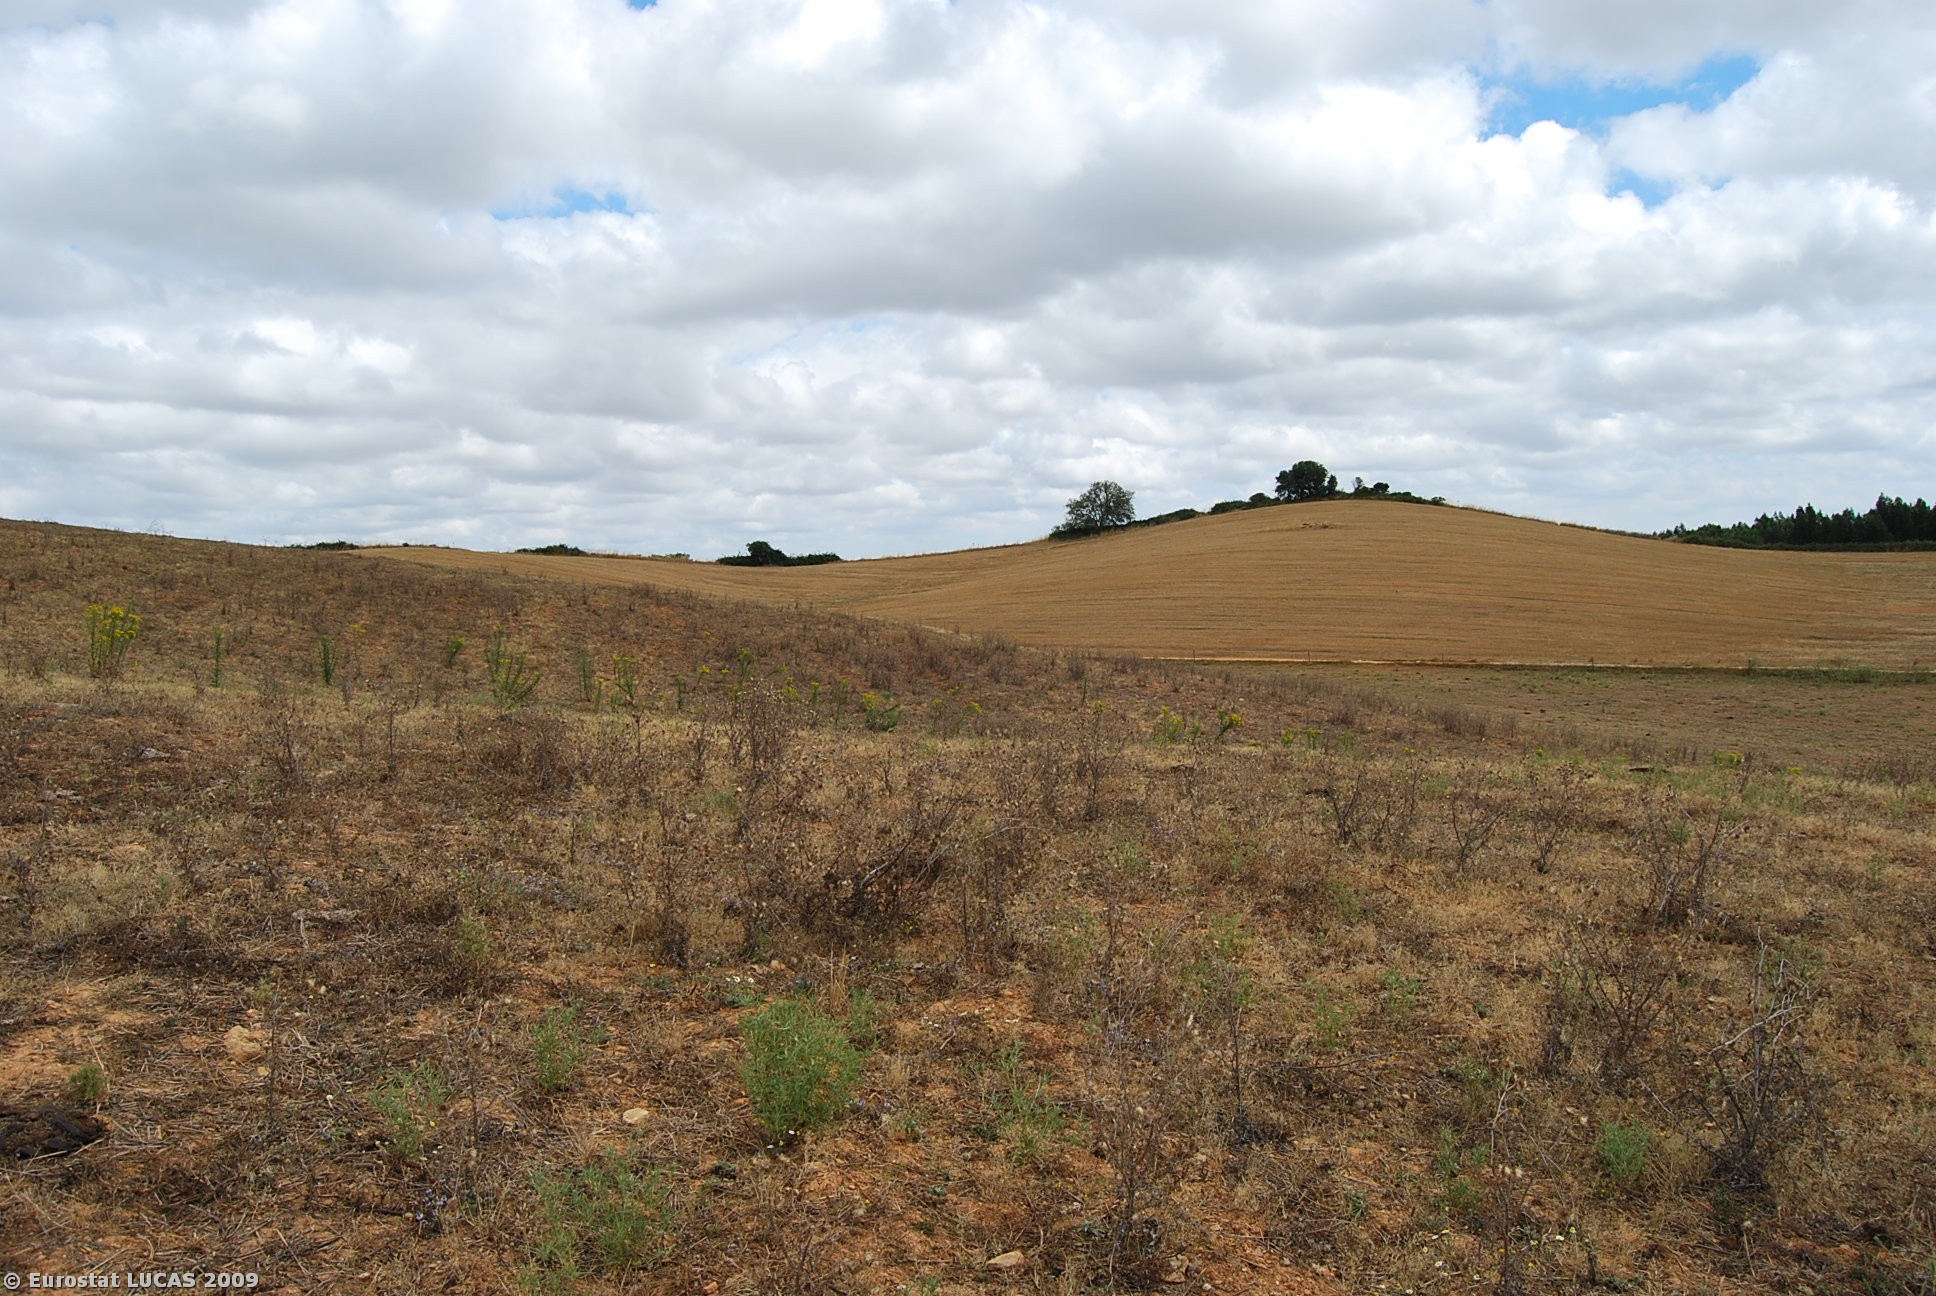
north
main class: Grassland
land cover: Grassland without tree/shrub cover
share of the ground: > 75 %
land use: Agriculture (excluding fallow land and kitchen gardens)
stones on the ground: 10 - 25 %
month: June
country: PT
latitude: 37.7055
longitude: -8.6309
